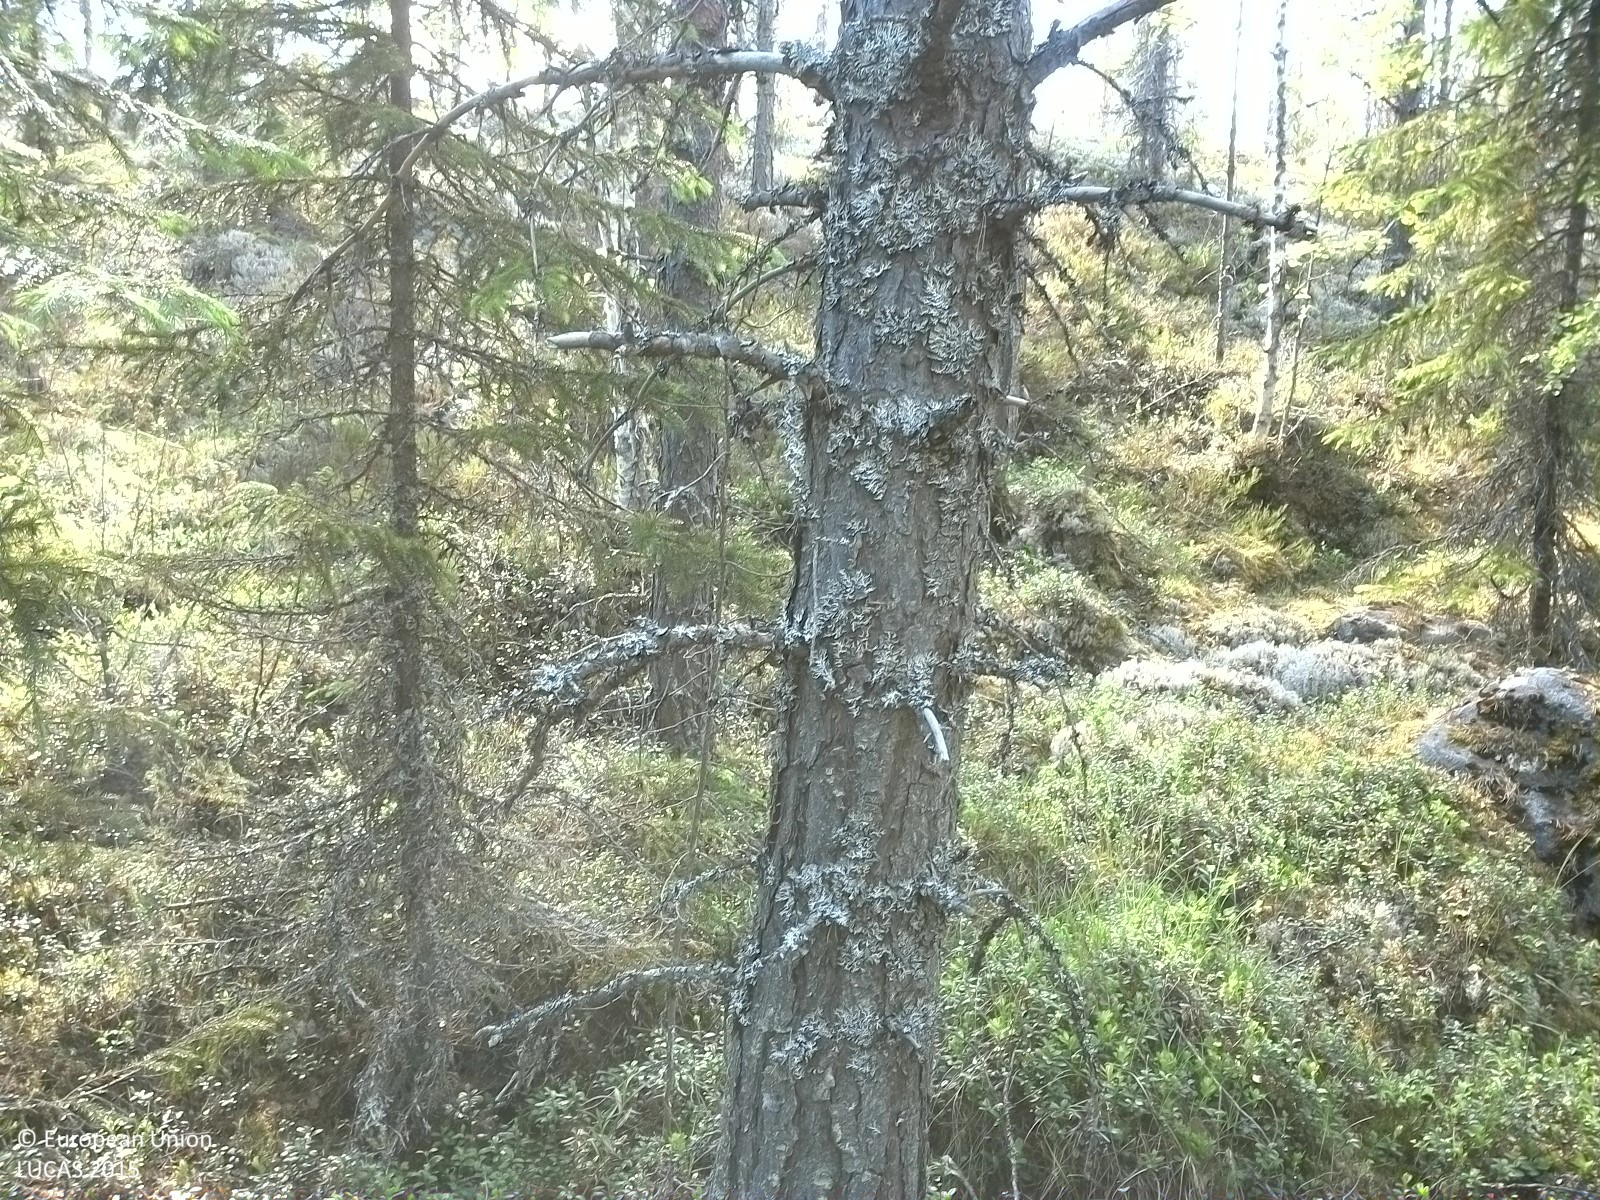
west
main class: Woodland
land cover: Other mixed woodland
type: boreal forest
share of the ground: 25 - 50 %
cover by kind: broadleaved forest trees 30 %, shrubs 30 %, coniferous forest trees 20 %, lichens and mosses 20 %
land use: Forestry
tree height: > 5 m
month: June
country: SE
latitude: 62.1682
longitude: 16.4127
